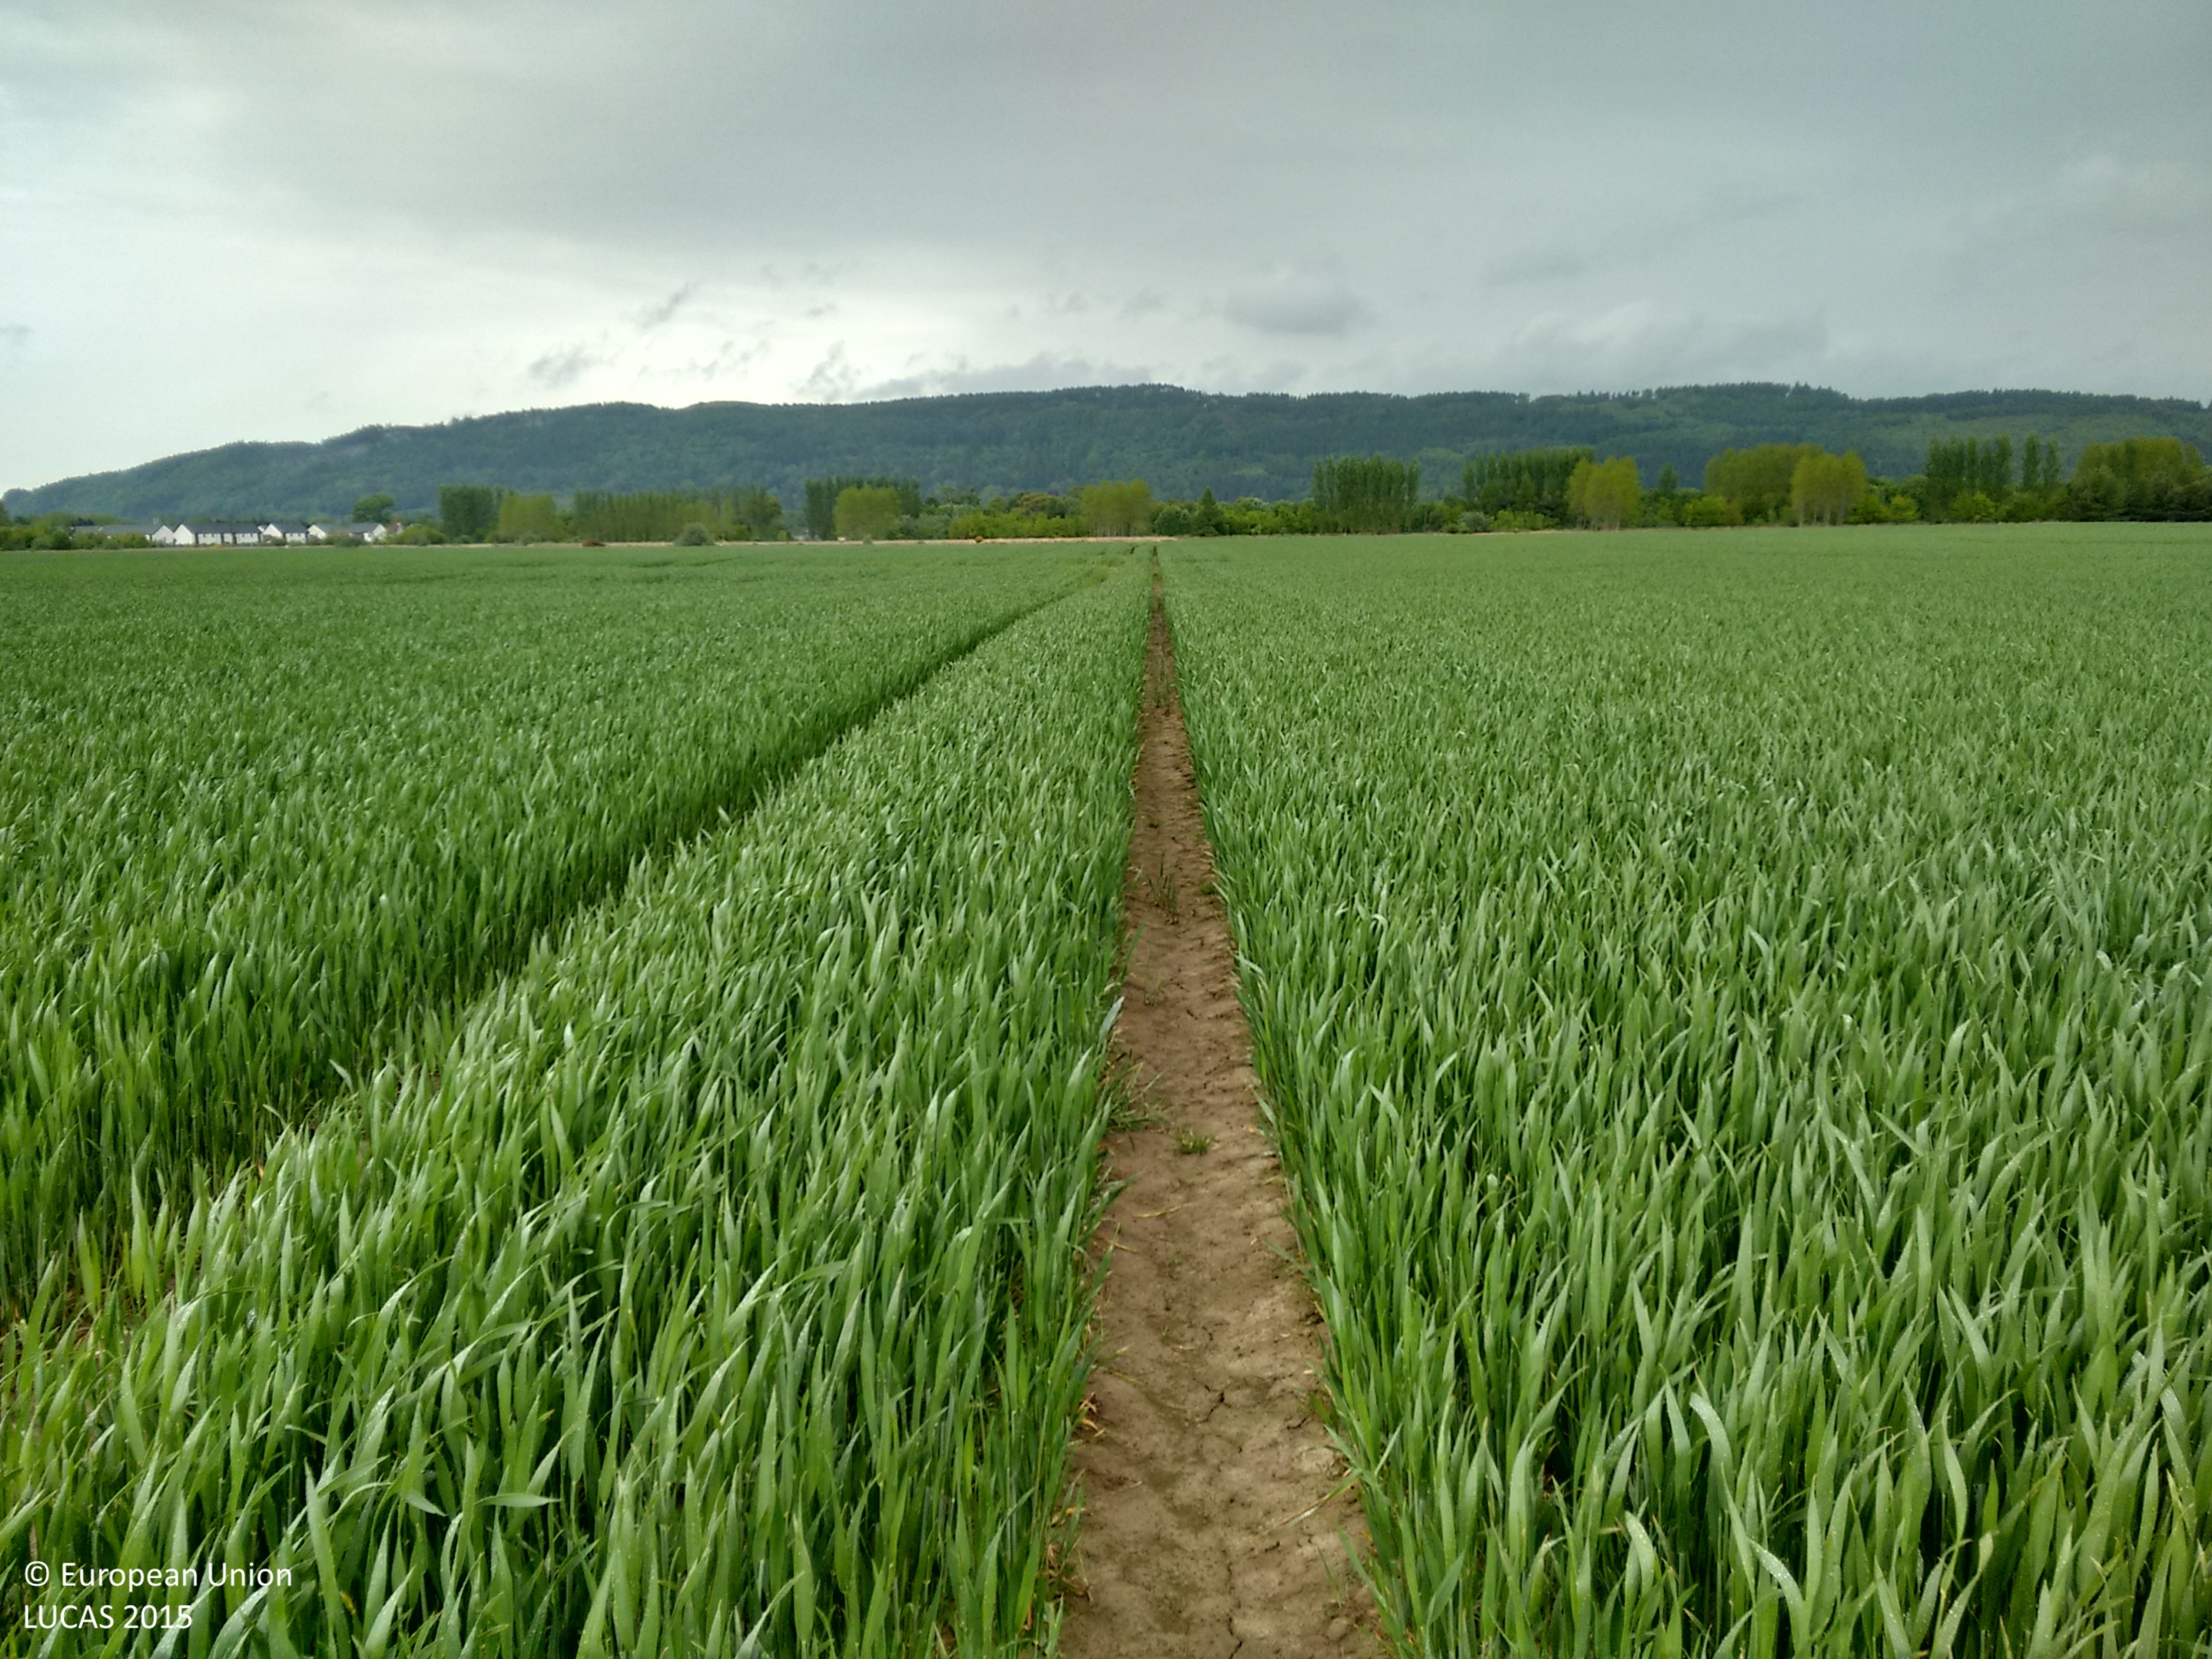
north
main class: Cropland
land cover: Common wheat
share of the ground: > 75 %
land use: Agriculture (excluding fallow land and kitchen gardens)
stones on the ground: < 10 %
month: June
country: GB
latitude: 56.3401
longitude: -3.3875
